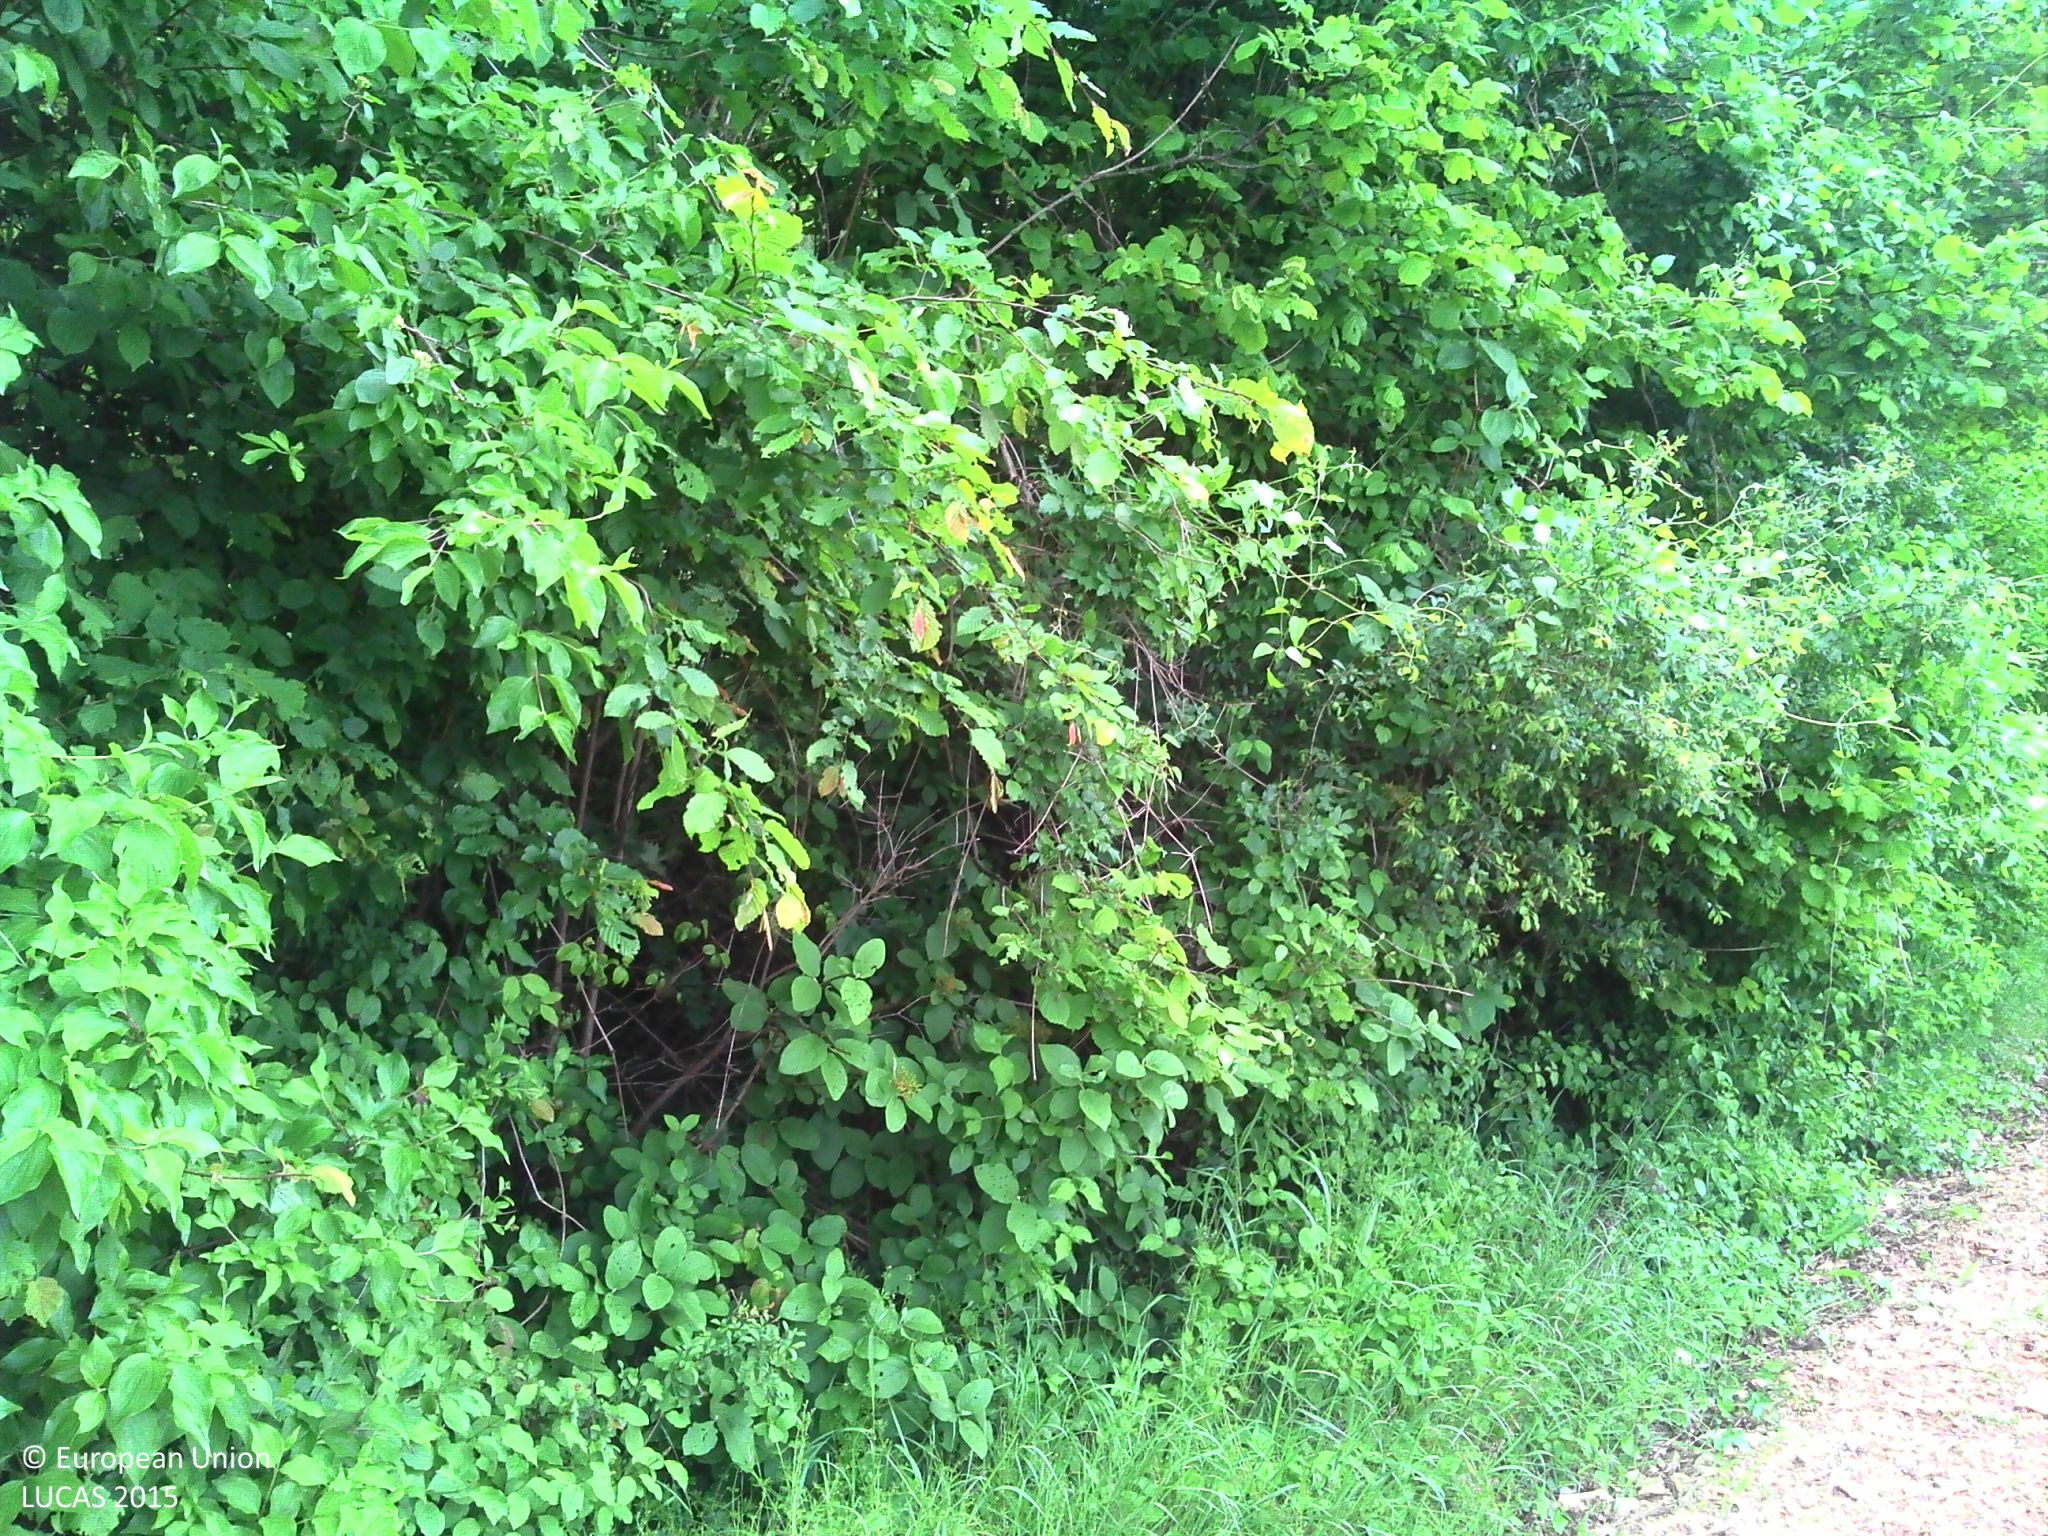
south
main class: Cropland
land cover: Rape and turnip rape
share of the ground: > 75 %
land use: Agriculture (excluding fallow land and kitchen gardens)
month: May
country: FR
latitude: 47.4981
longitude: 5.0221
